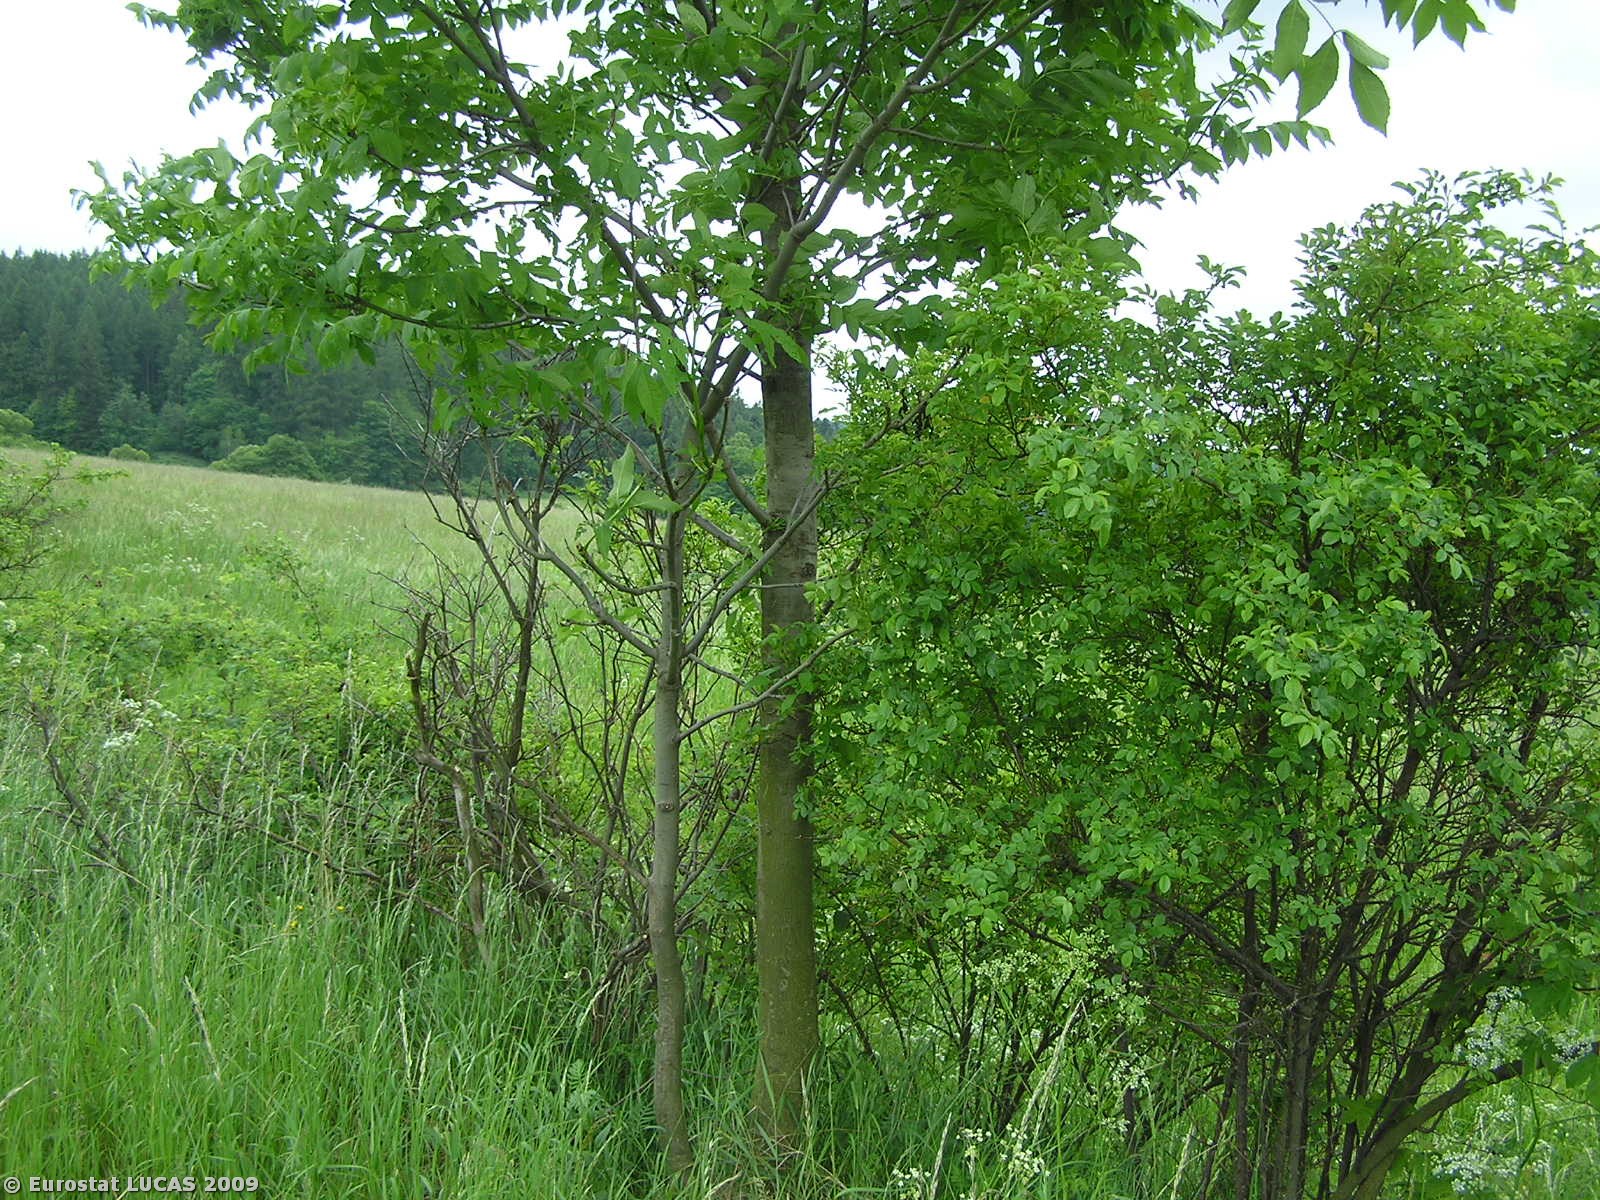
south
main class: Grassland
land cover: Grassland without tree/shrub cover
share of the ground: > 75 %
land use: Agriculture (excluding fallow land and kitchen gardens)
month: June
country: CZ
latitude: 50.0644
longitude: 17.4862
